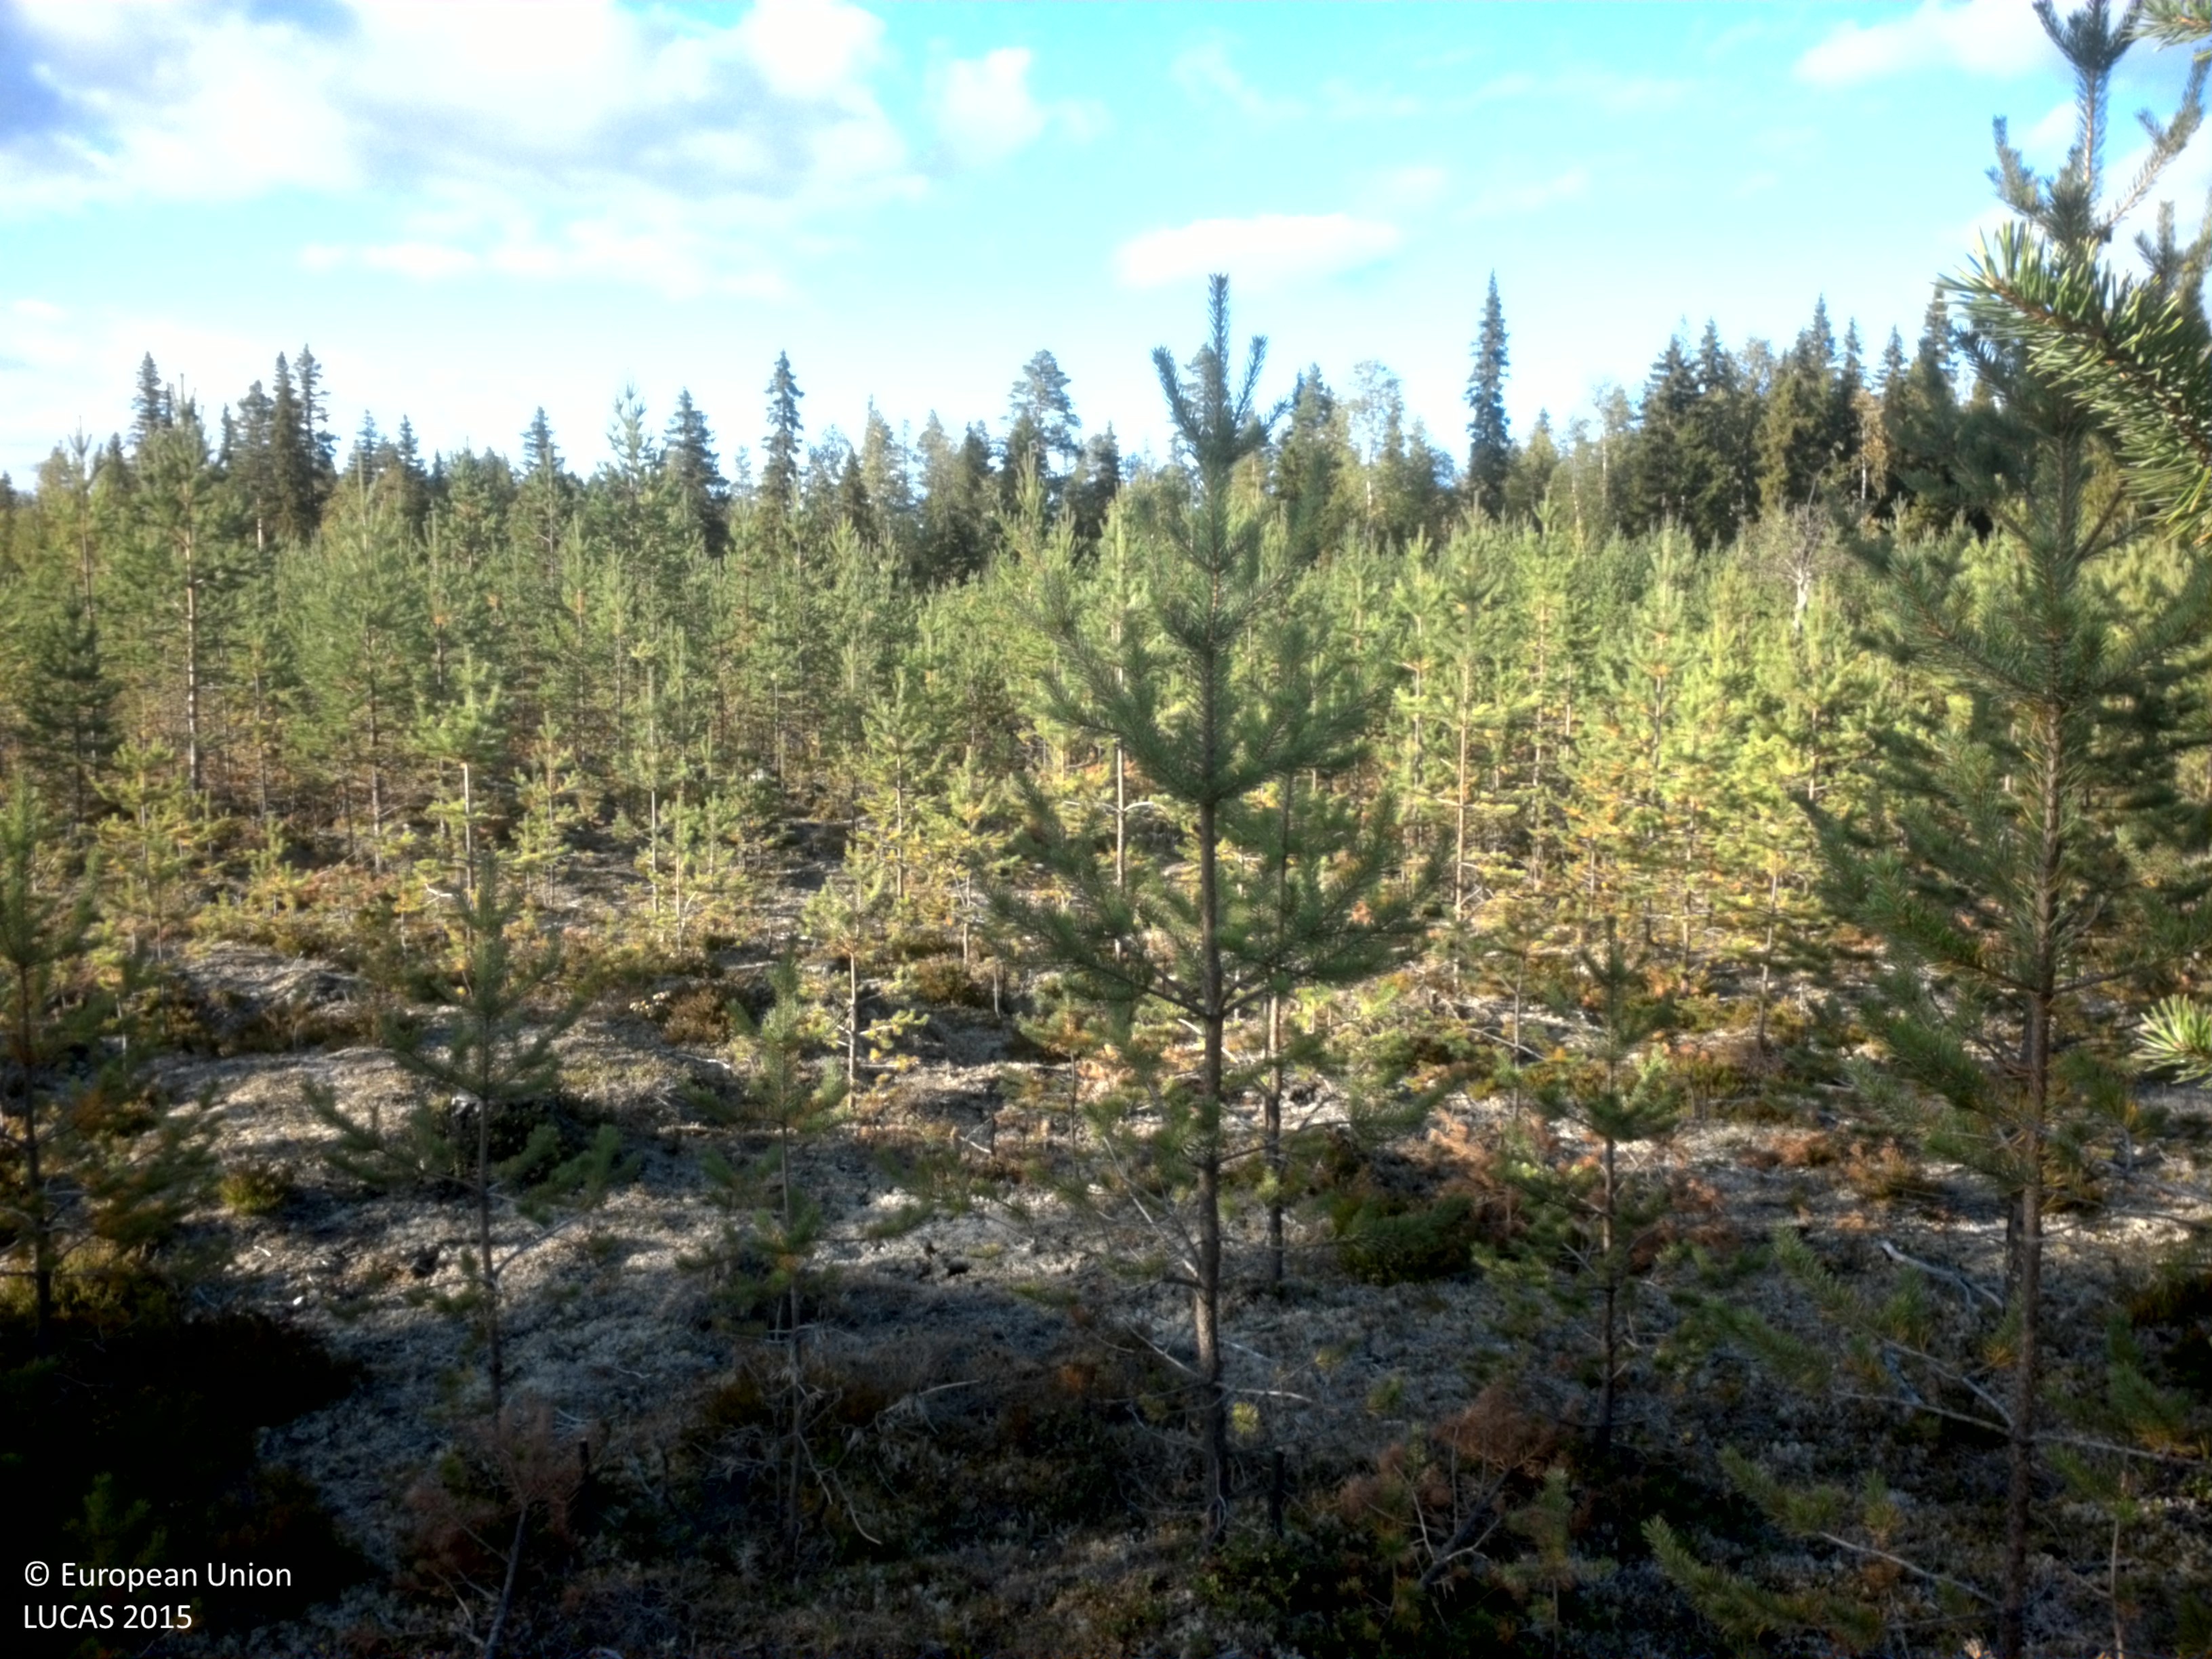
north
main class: Woodland
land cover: Pine dominated coniferous woodland
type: boreal forest
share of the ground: 50 - 75 %
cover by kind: coniferous forest trees 65 %, lichens and mosses 25 %, shrubs 10 %
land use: Forestry
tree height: < 5 m
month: September
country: SE
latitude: 64.4355
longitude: 18.9633
